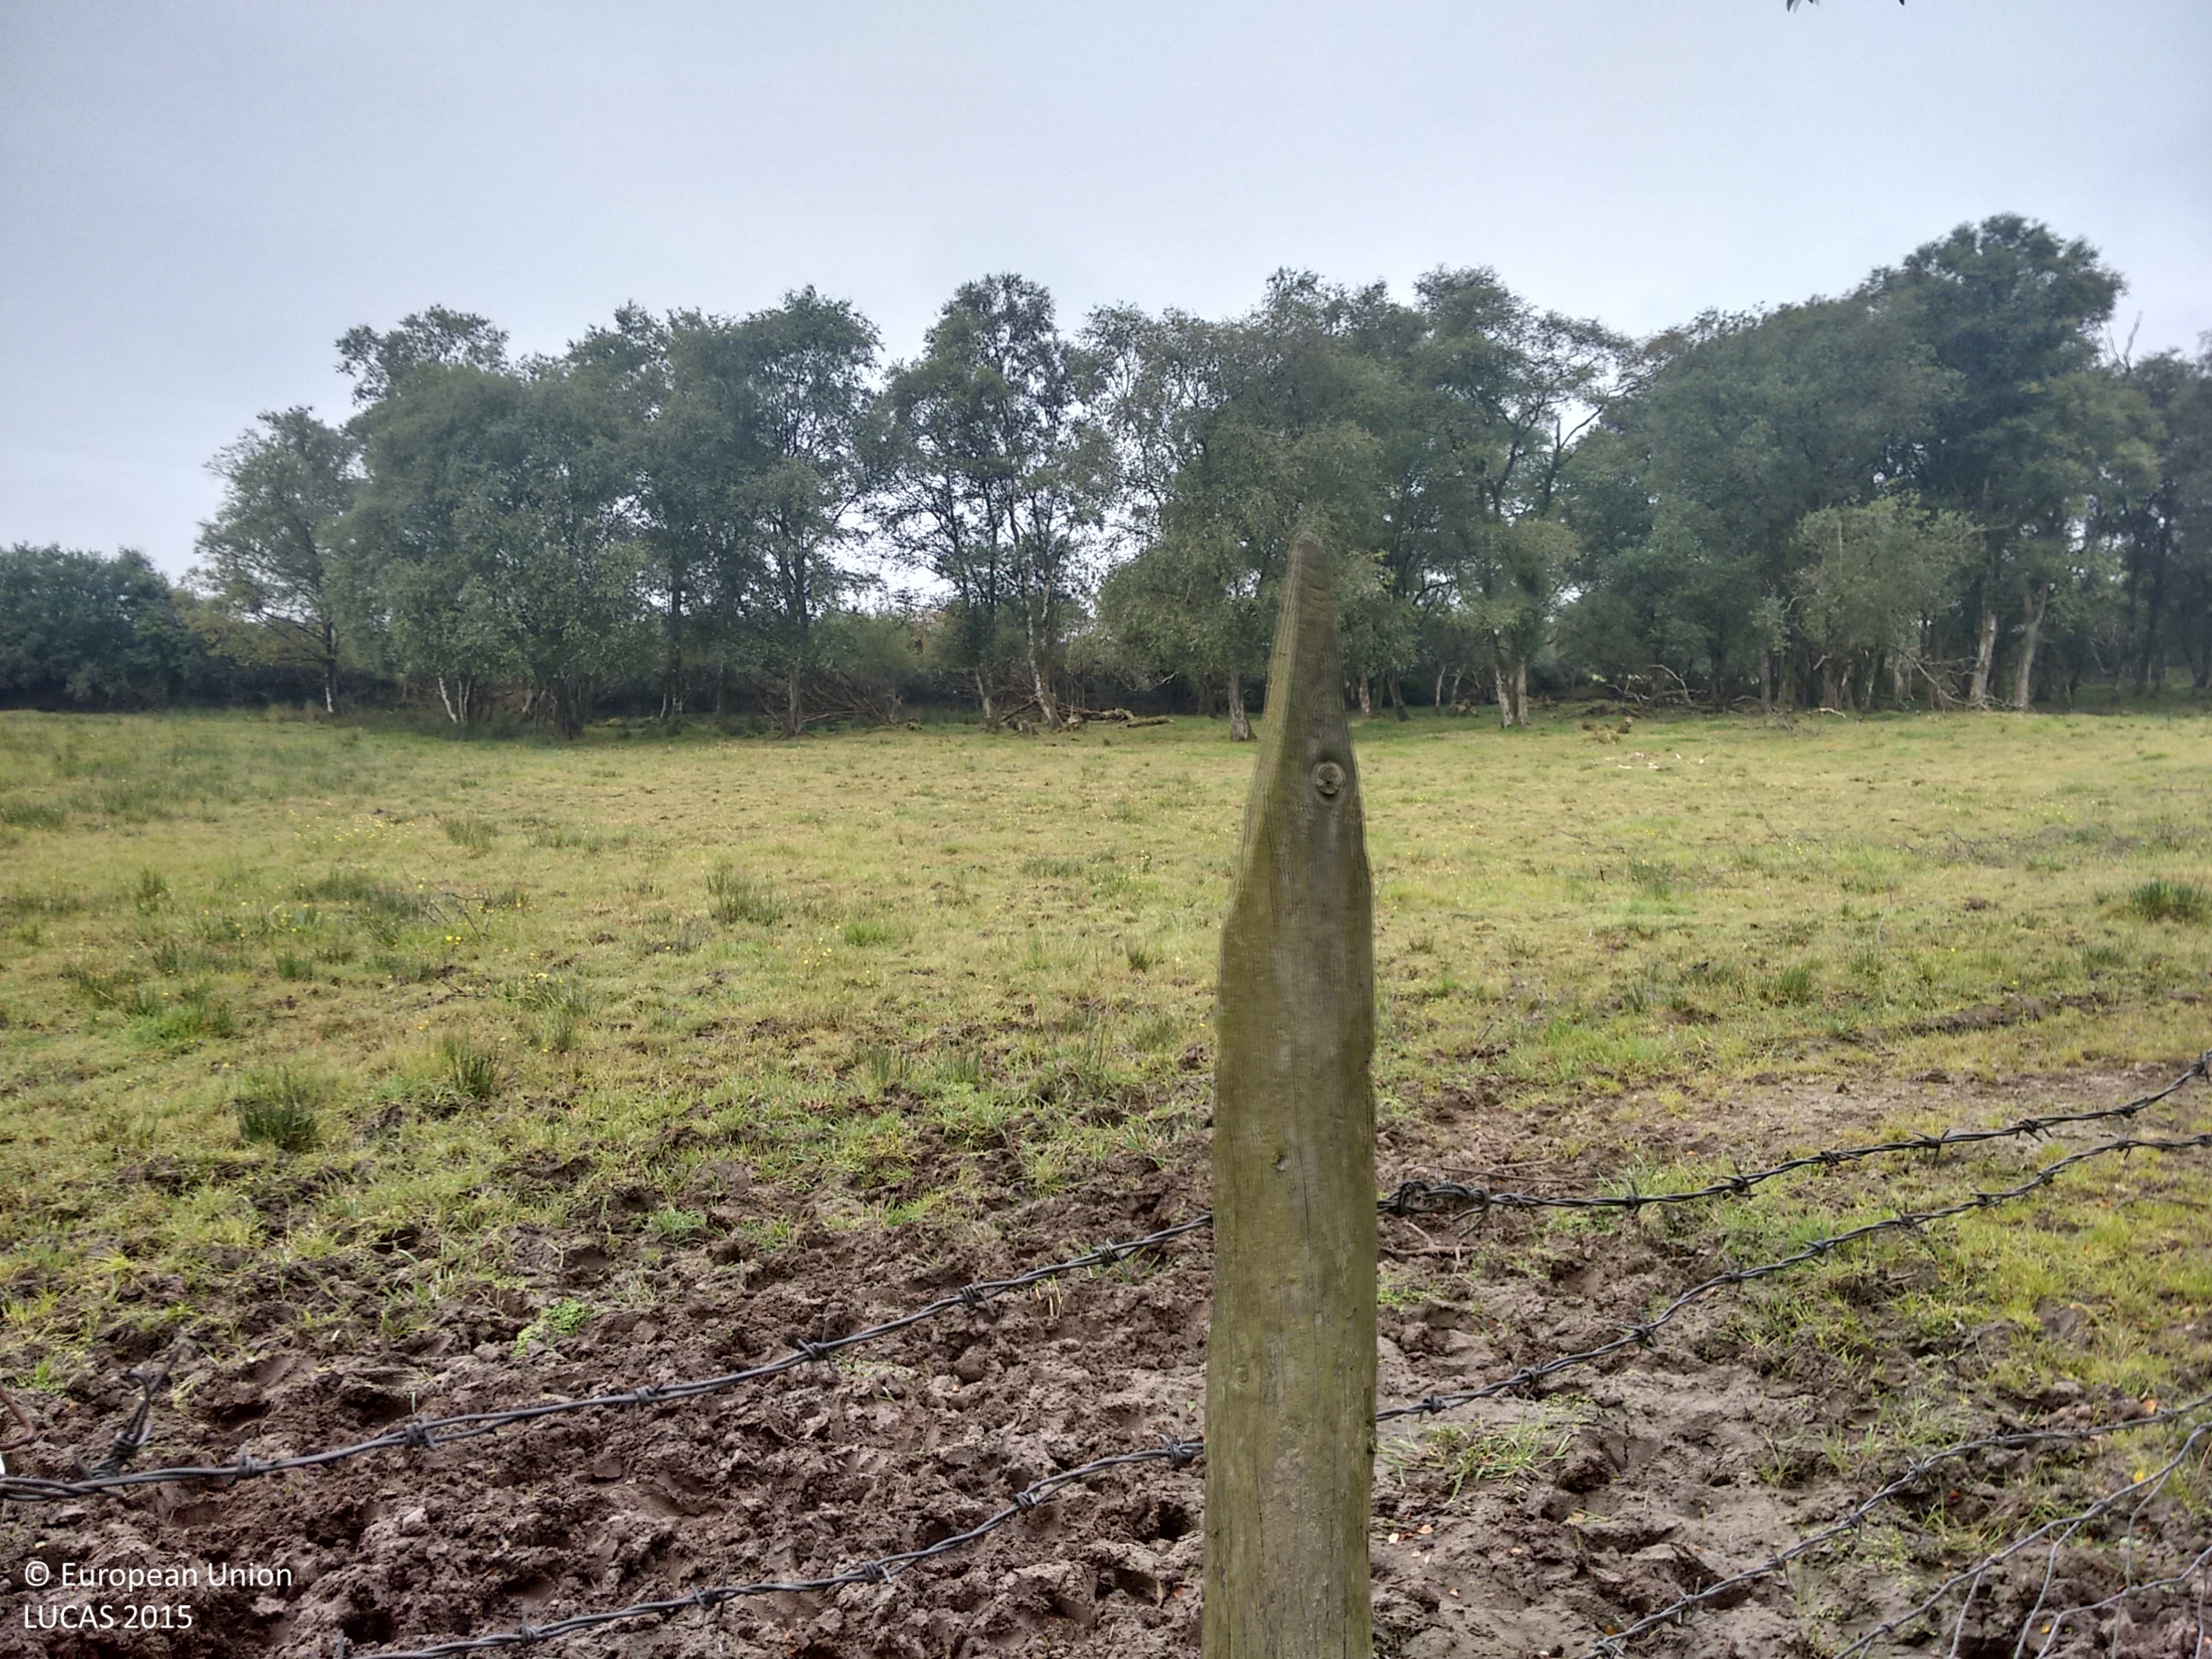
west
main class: Grassland
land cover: Grassland without tree/shrub cover
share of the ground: > 75 %
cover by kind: herbaceous plants 100 %
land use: Agriculture (excluding fallow land and kitchen gardens)
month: September
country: IE
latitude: 55.0729
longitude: -7.2964
